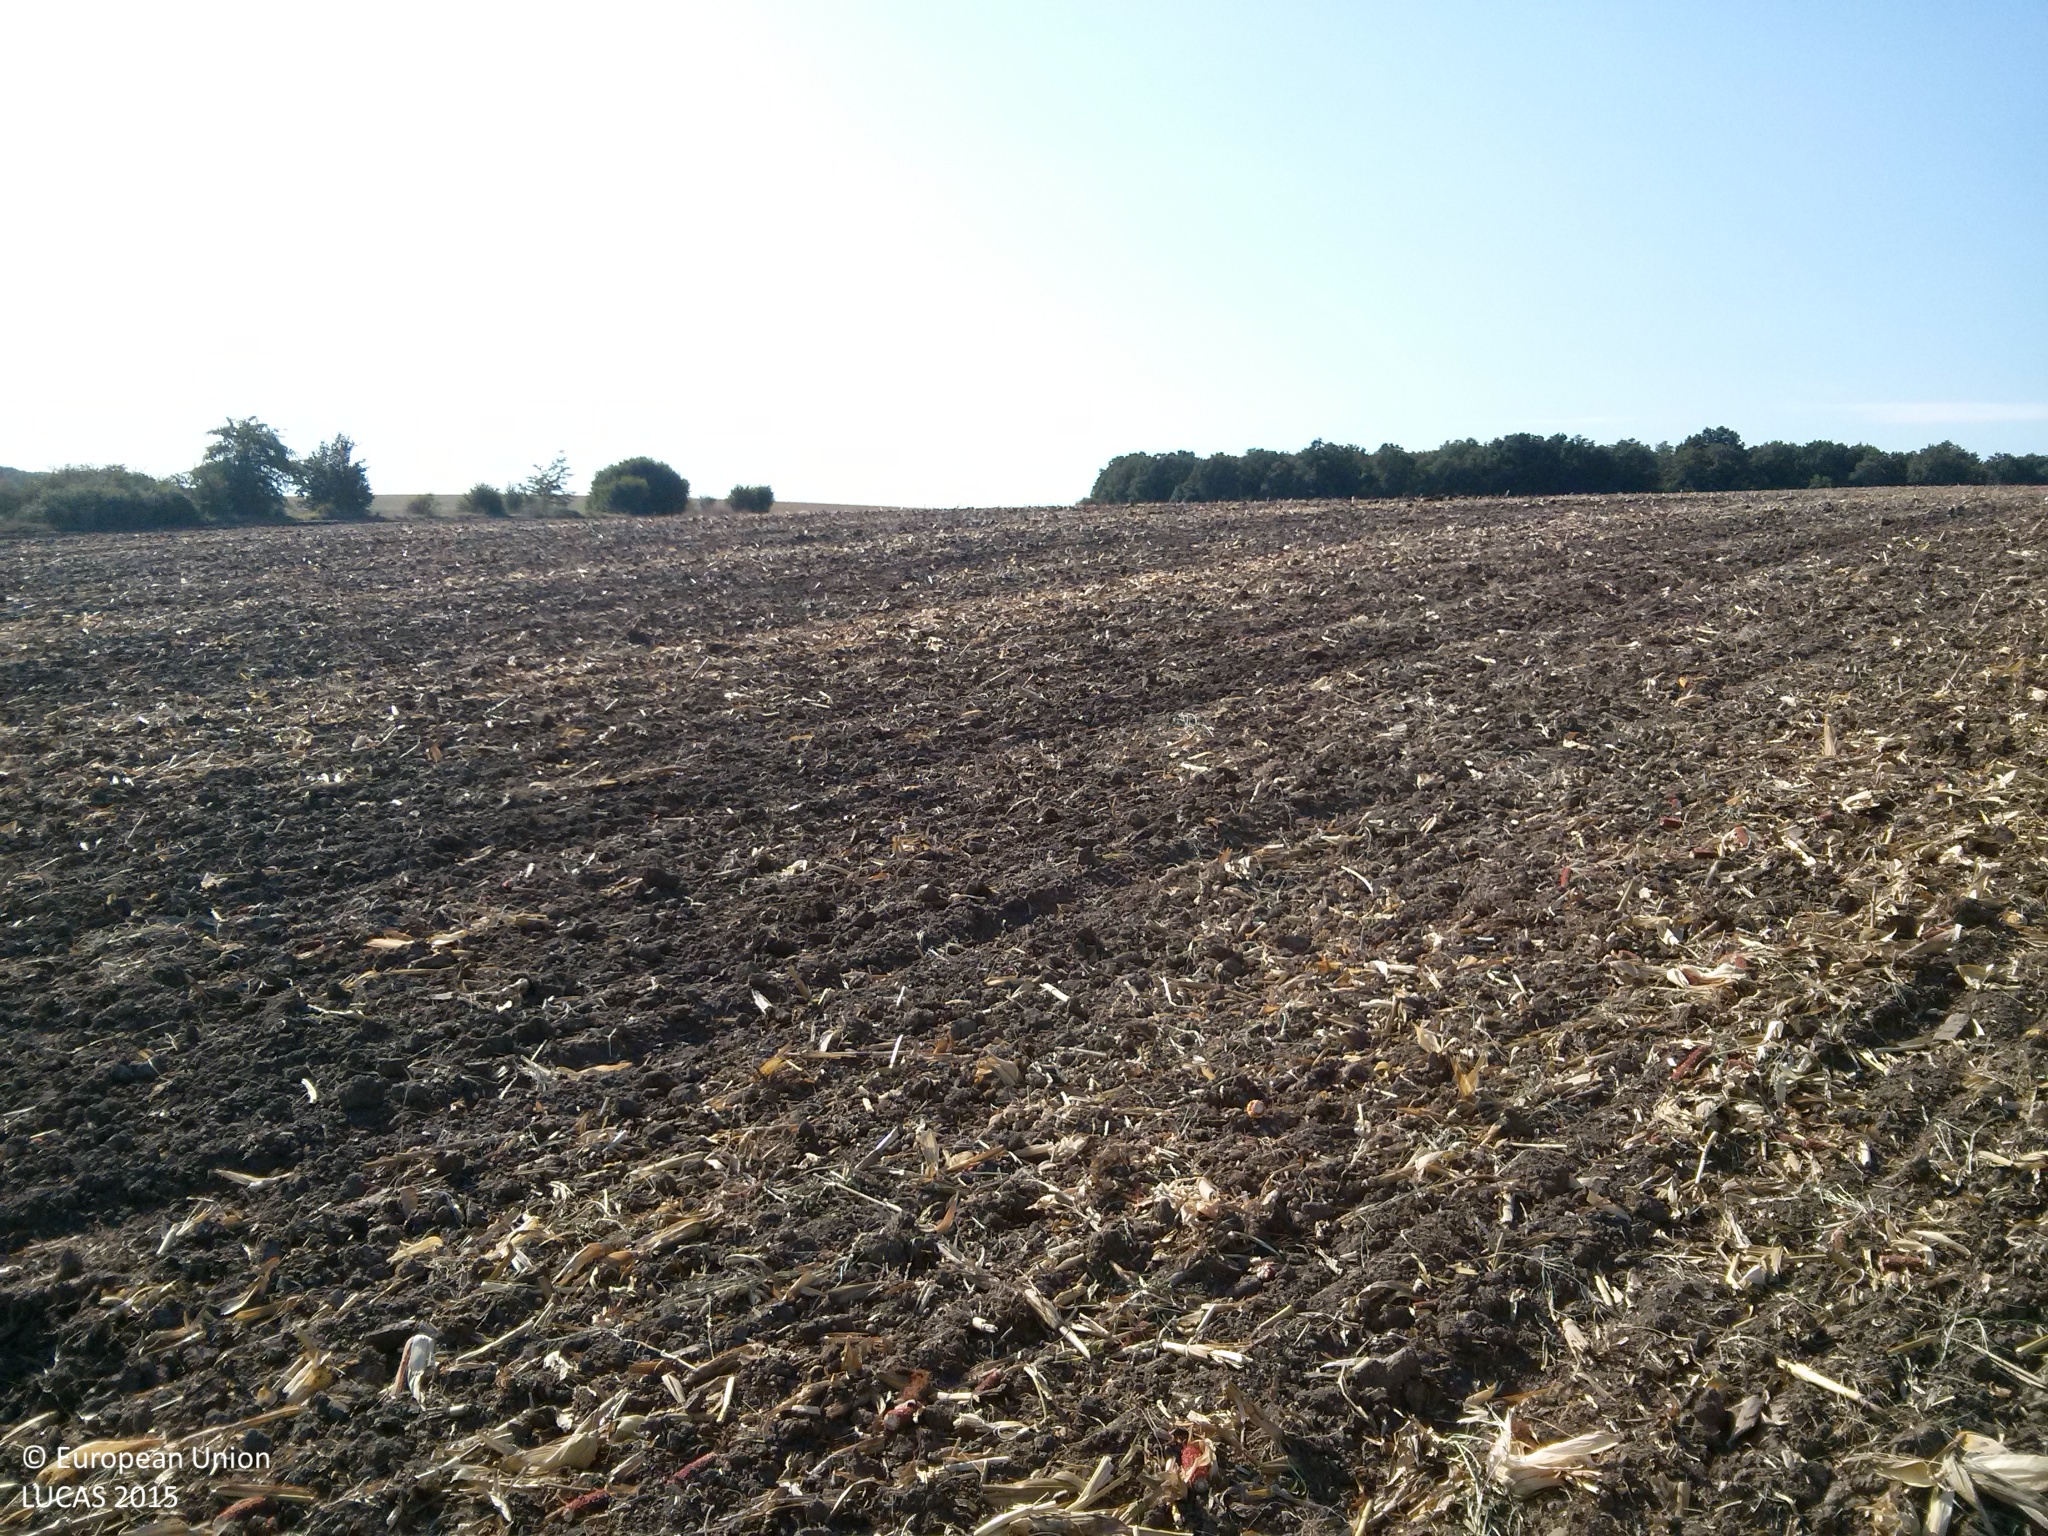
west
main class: Cropland
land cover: Maize
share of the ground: < 10 %
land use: Agriculture (excluding fallow land and kitchen gardens)
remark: Harvested field
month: September
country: BG
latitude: 43.9038
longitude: 26.4815
